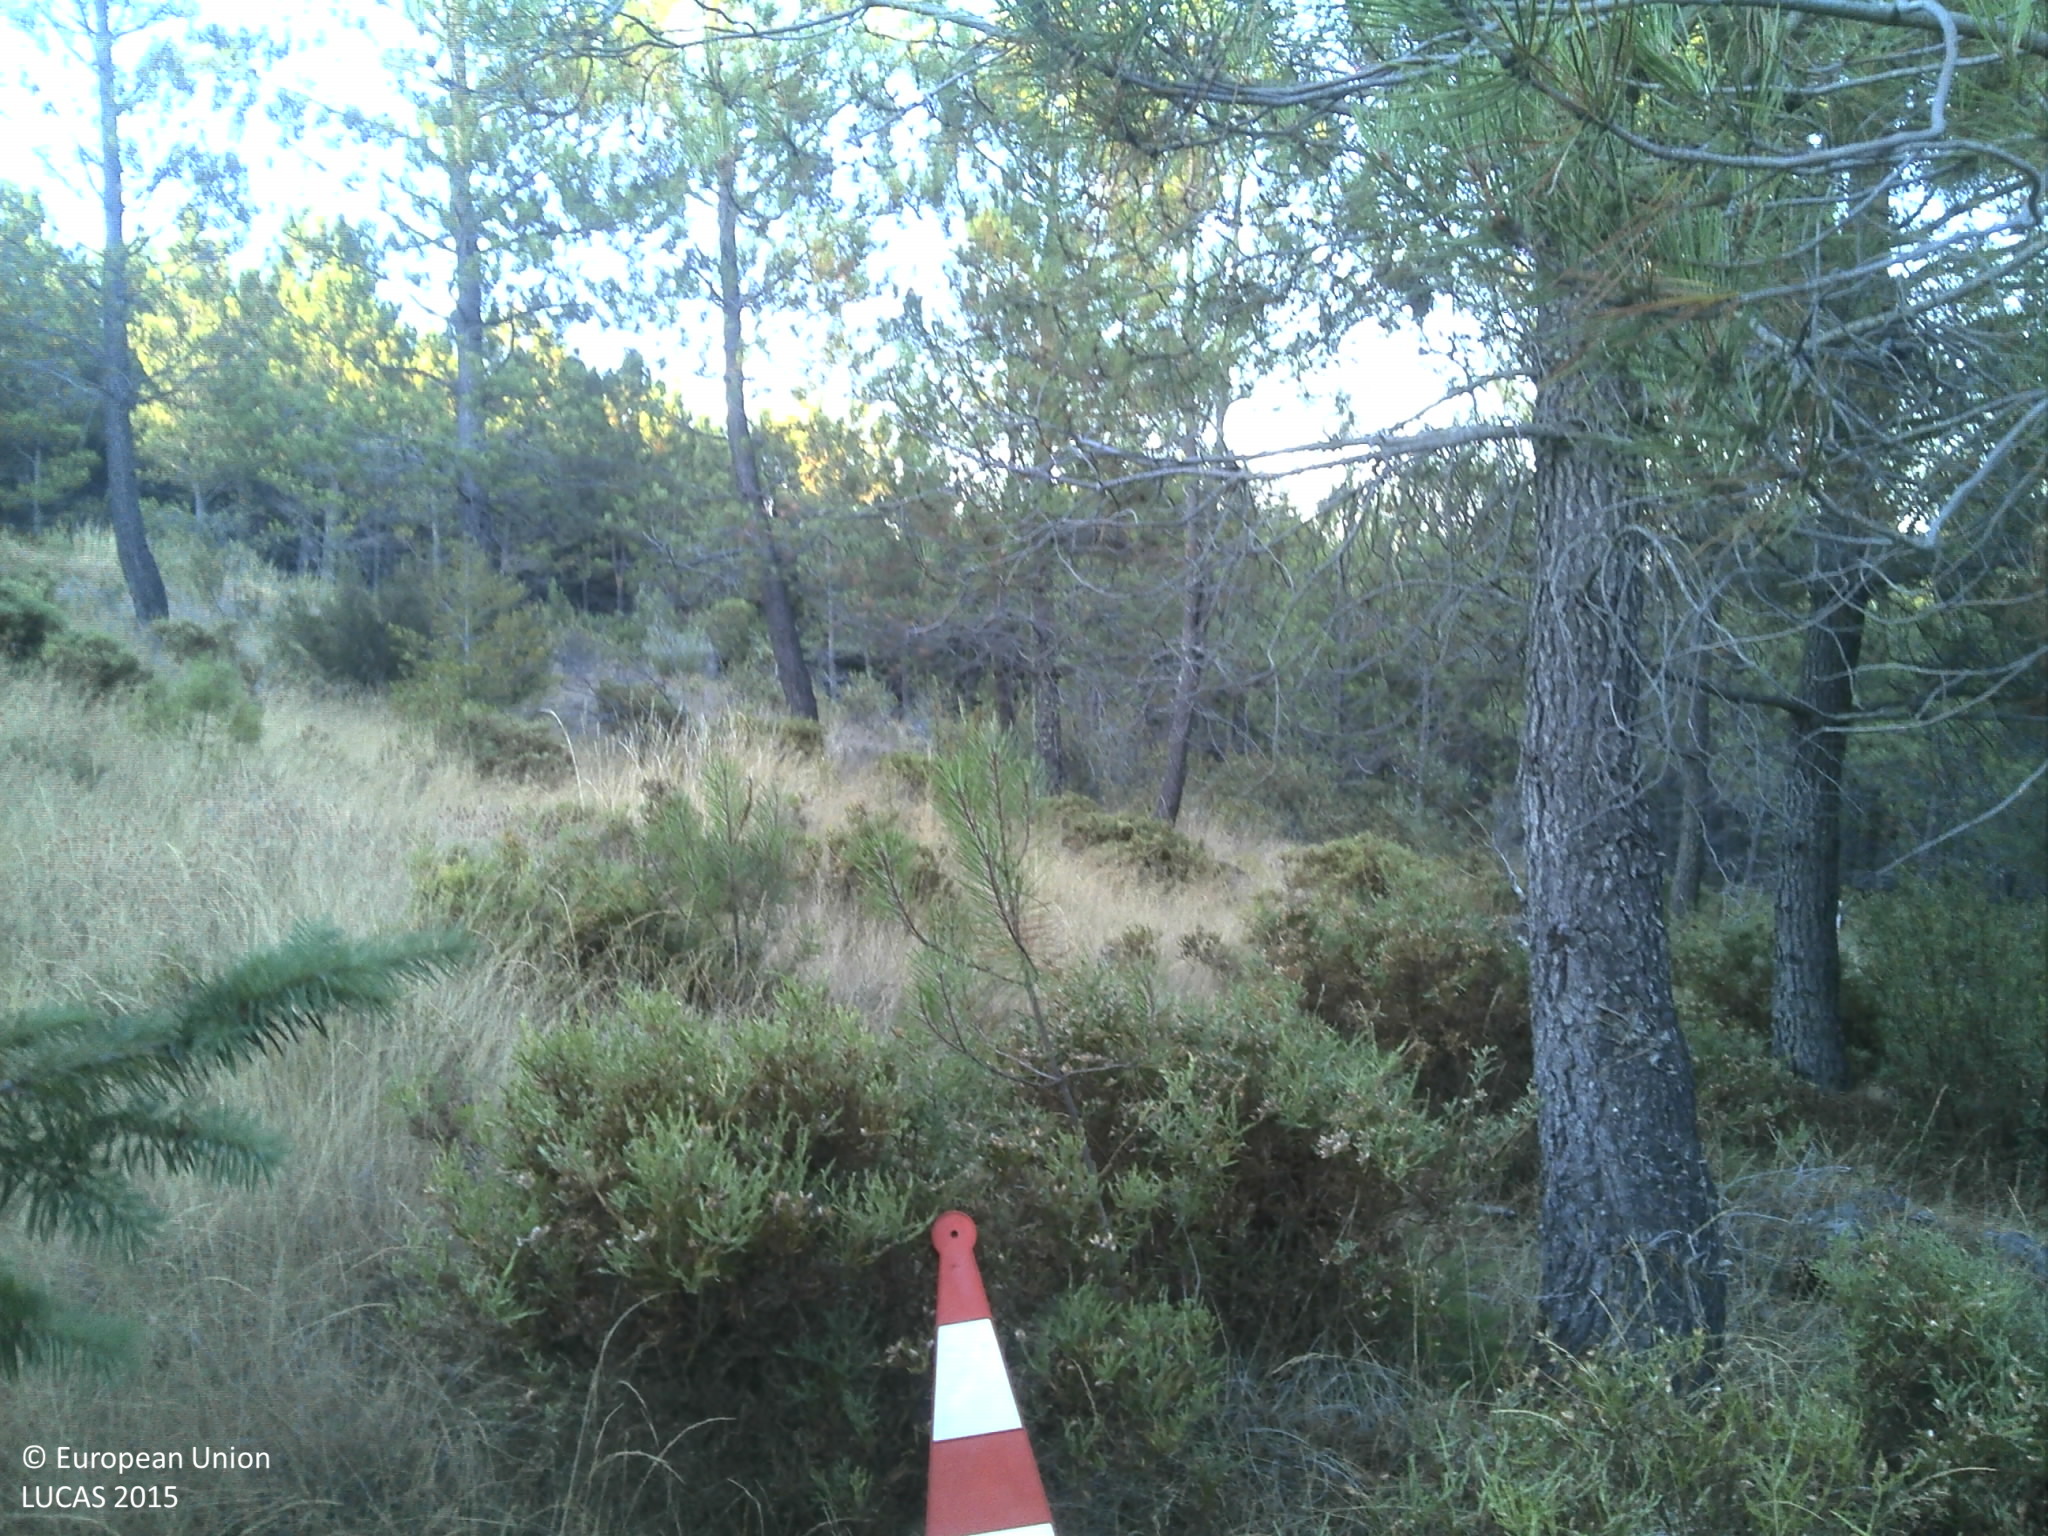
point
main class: Woodland
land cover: Pine dominated coniferous woodland
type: coniferous forest of the mediterranean region
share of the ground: 50 - 75 %
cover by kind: coniferous forest trees 60 %, shrubs 15 %, unconsolidated bare surface 15 %
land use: Forestry
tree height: > 5 m
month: August
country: PT
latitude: 40.4427
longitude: -7.4515
